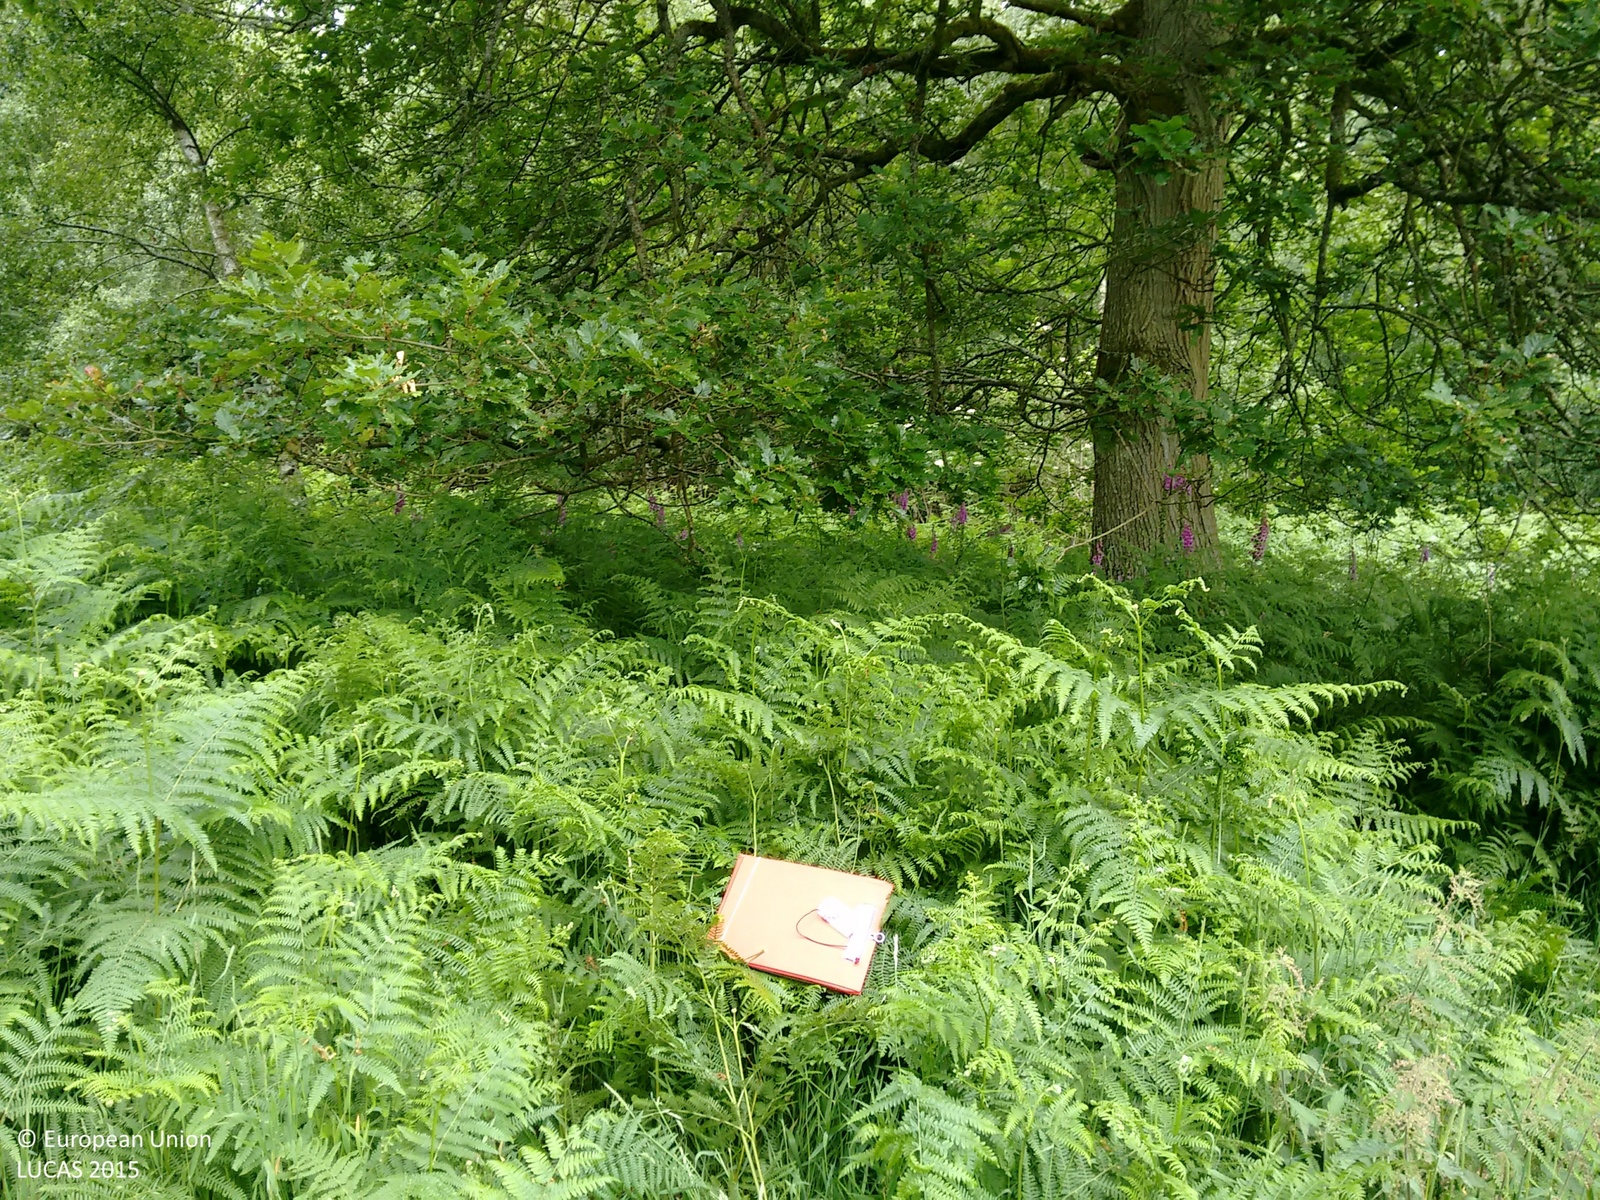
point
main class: Woodland
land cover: Broadleaved woodland
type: mesophytic deciduous forest
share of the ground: > 75 %
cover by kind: broadleaved forest trees 95 %, shrubs 5 %
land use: Semi-natural and natural areas not in use
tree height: > 5 m
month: June
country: GB
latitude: 52.3433
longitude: -2.7380
